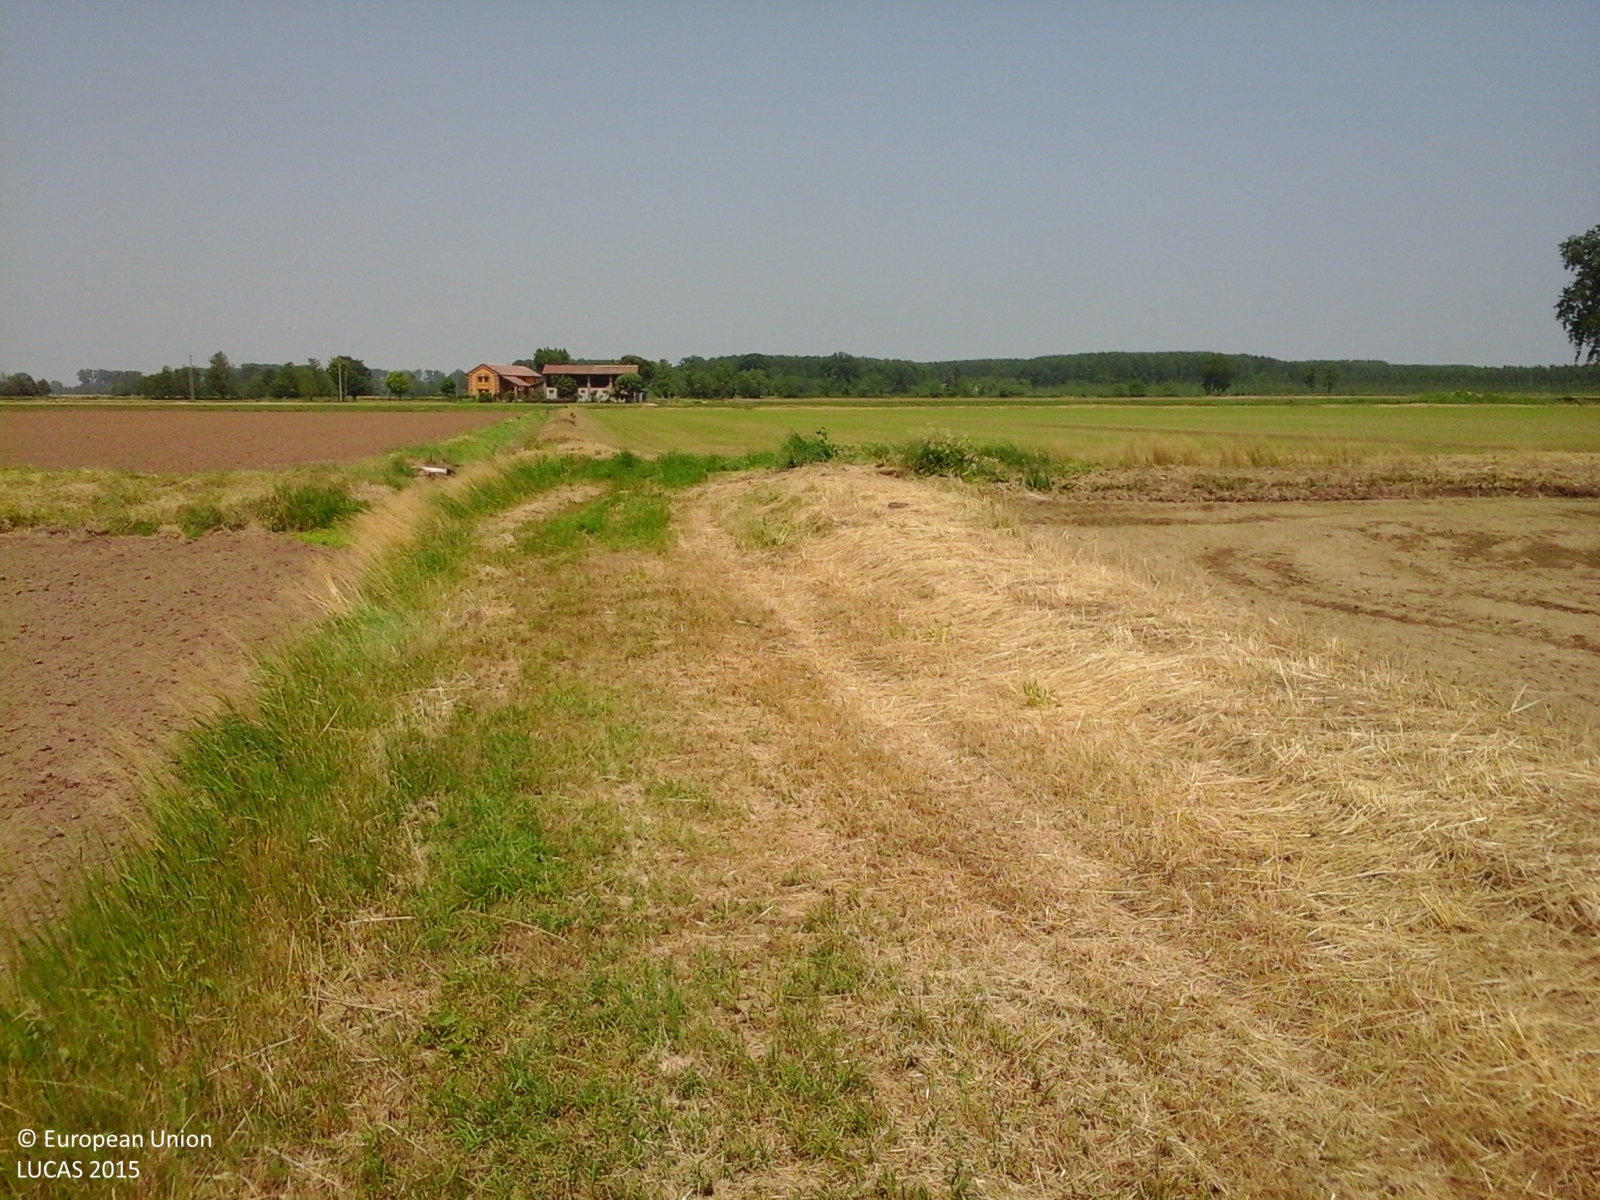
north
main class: Cropland
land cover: Rice
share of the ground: < 10 %
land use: Agriculture (excluding fallow land and kitchen gardens)
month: May
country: IT
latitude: 45.2482
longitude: 9.0970
